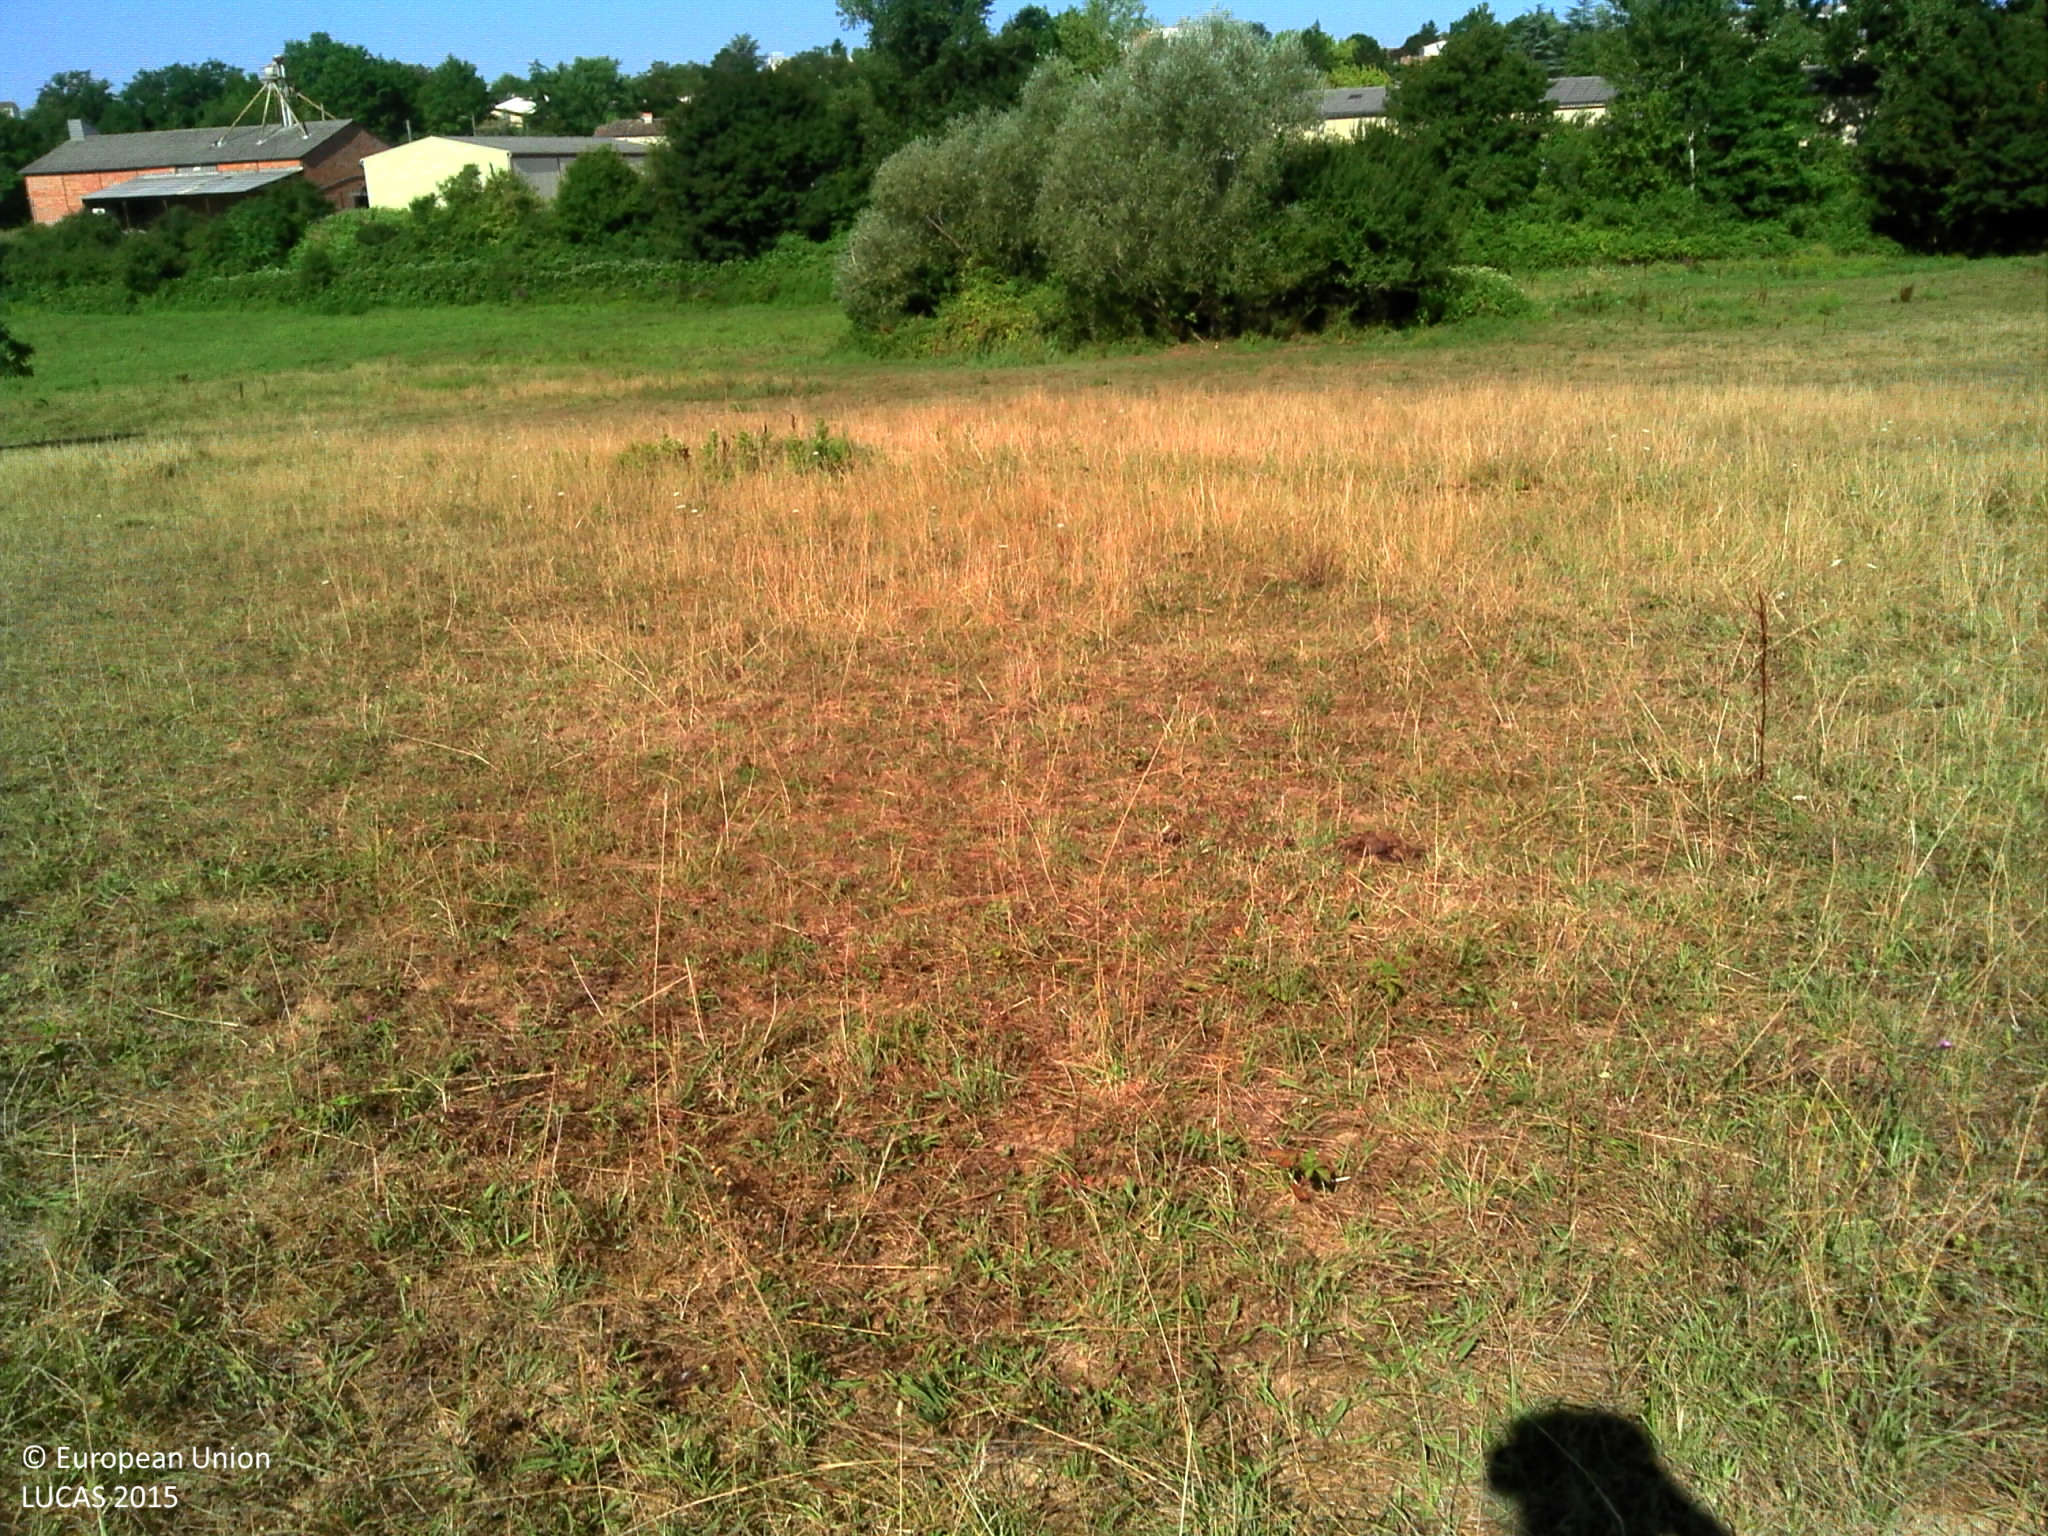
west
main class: Grassland
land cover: Grassland without tree/shrub cover
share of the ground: > 75 %
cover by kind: herbaceous plants 100 %
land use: Agriculture (excluding fallow land and kitchen gardens)
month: July
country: FR
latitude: 44.6487
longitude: 0.5983
